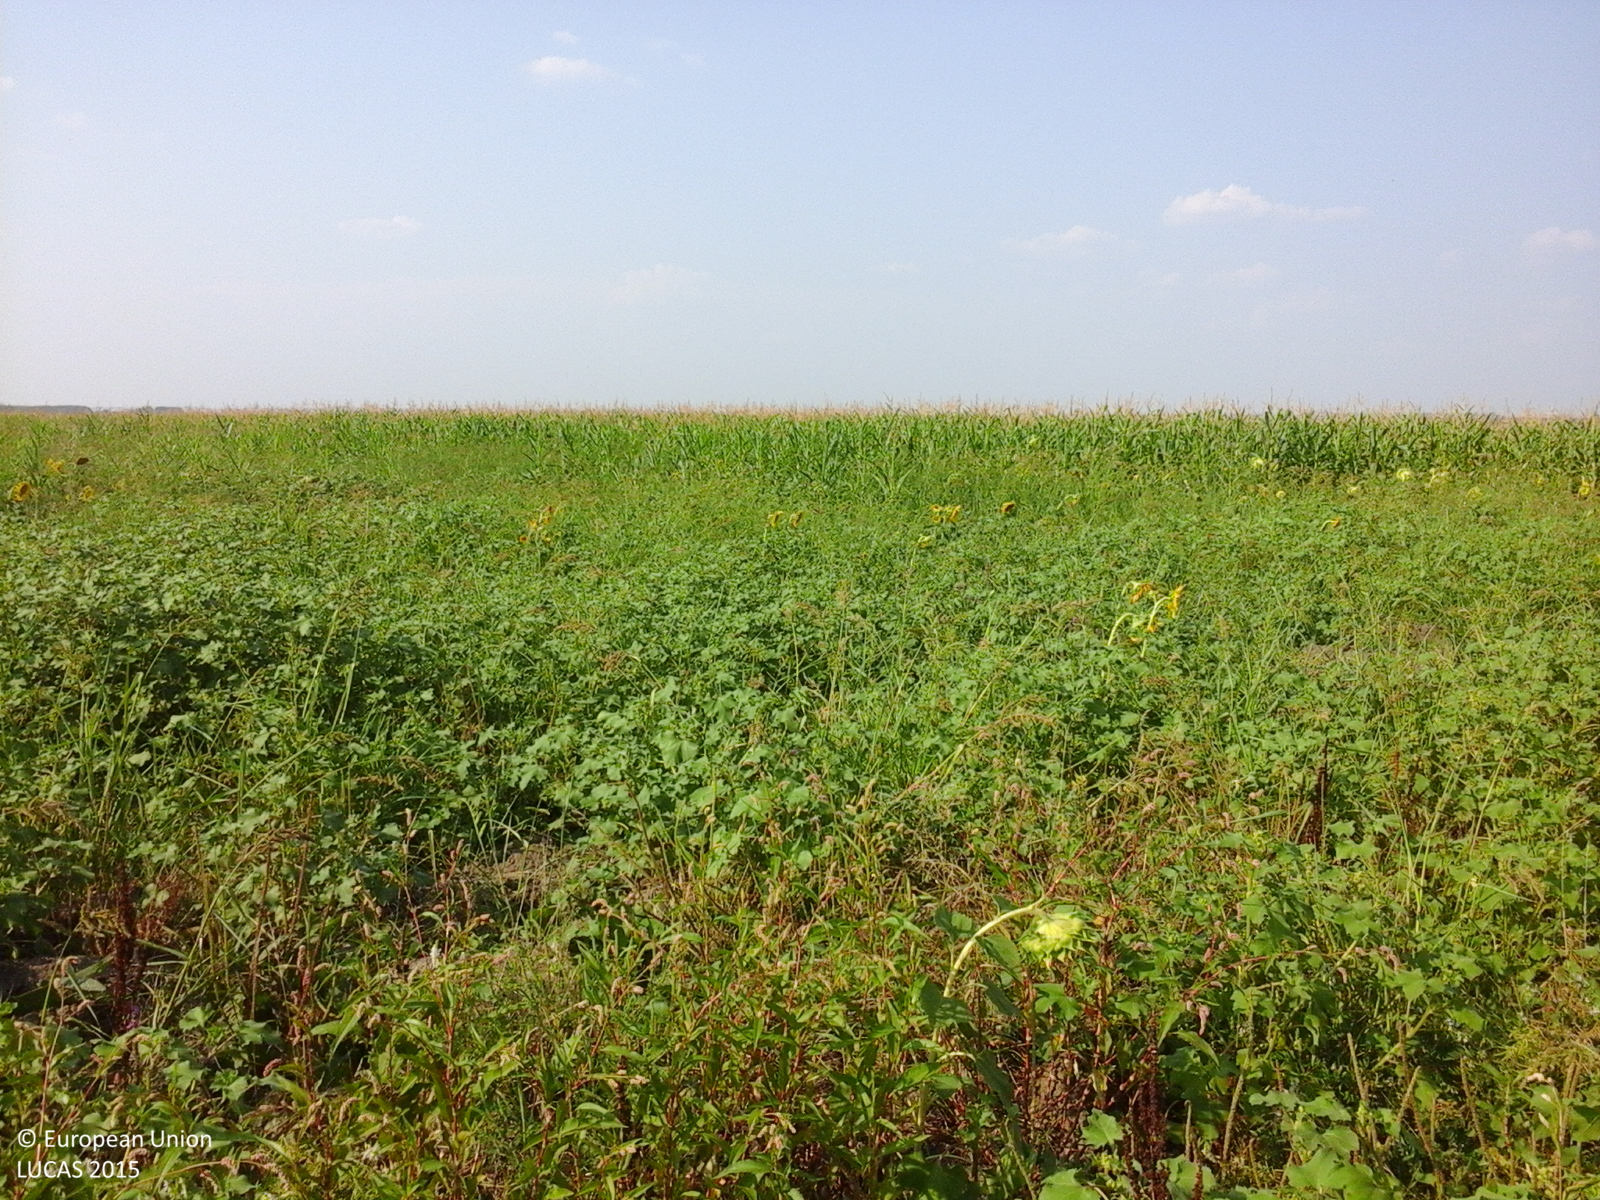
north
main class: Grassland
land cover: Spontaneously vegetated surfaces
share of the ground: > 75 %
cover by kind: herbaceous plants 100 %
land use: Agriculture (excluding fallow land and kitchen gardens)
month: August
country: RO
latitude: 44.3903
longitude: 23.6758
